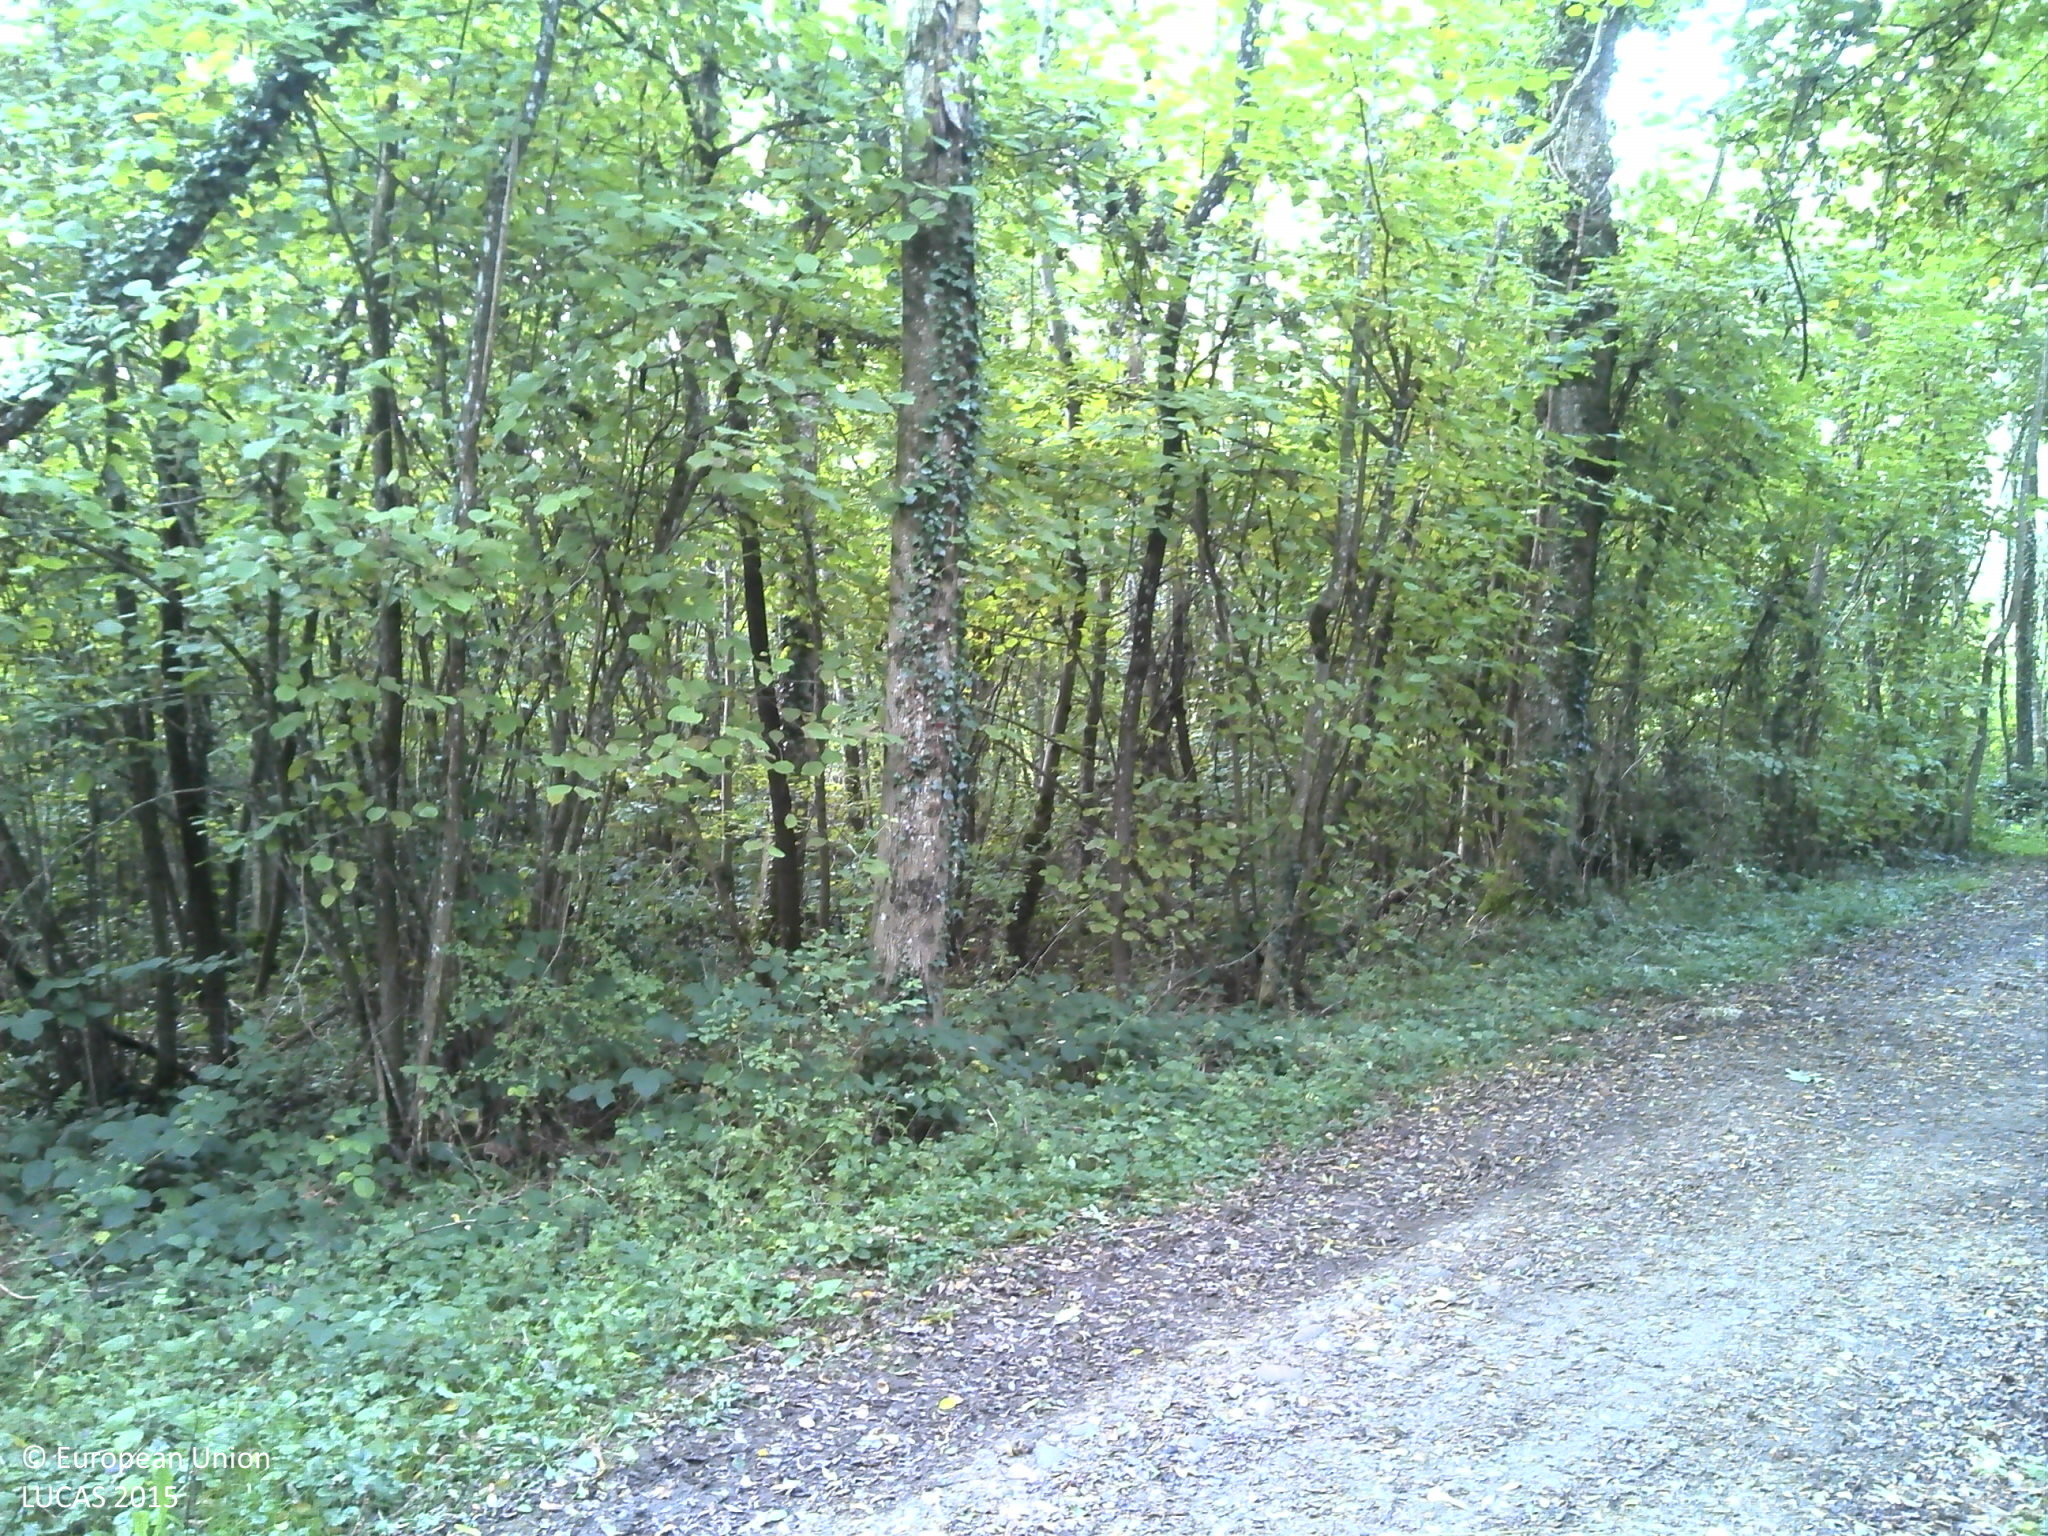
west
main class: Woodland
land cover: Broadleaved woodland
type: mesophytic deciduous forest
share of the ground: > 75 %
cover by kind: broadleaved forest trees 90 %, herbaceous plants 5 %, unconsolidated bare surface 5 %
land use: Forestry
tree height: > 5 m
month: October
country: FR
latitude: 45.9433
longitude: 5.3470
